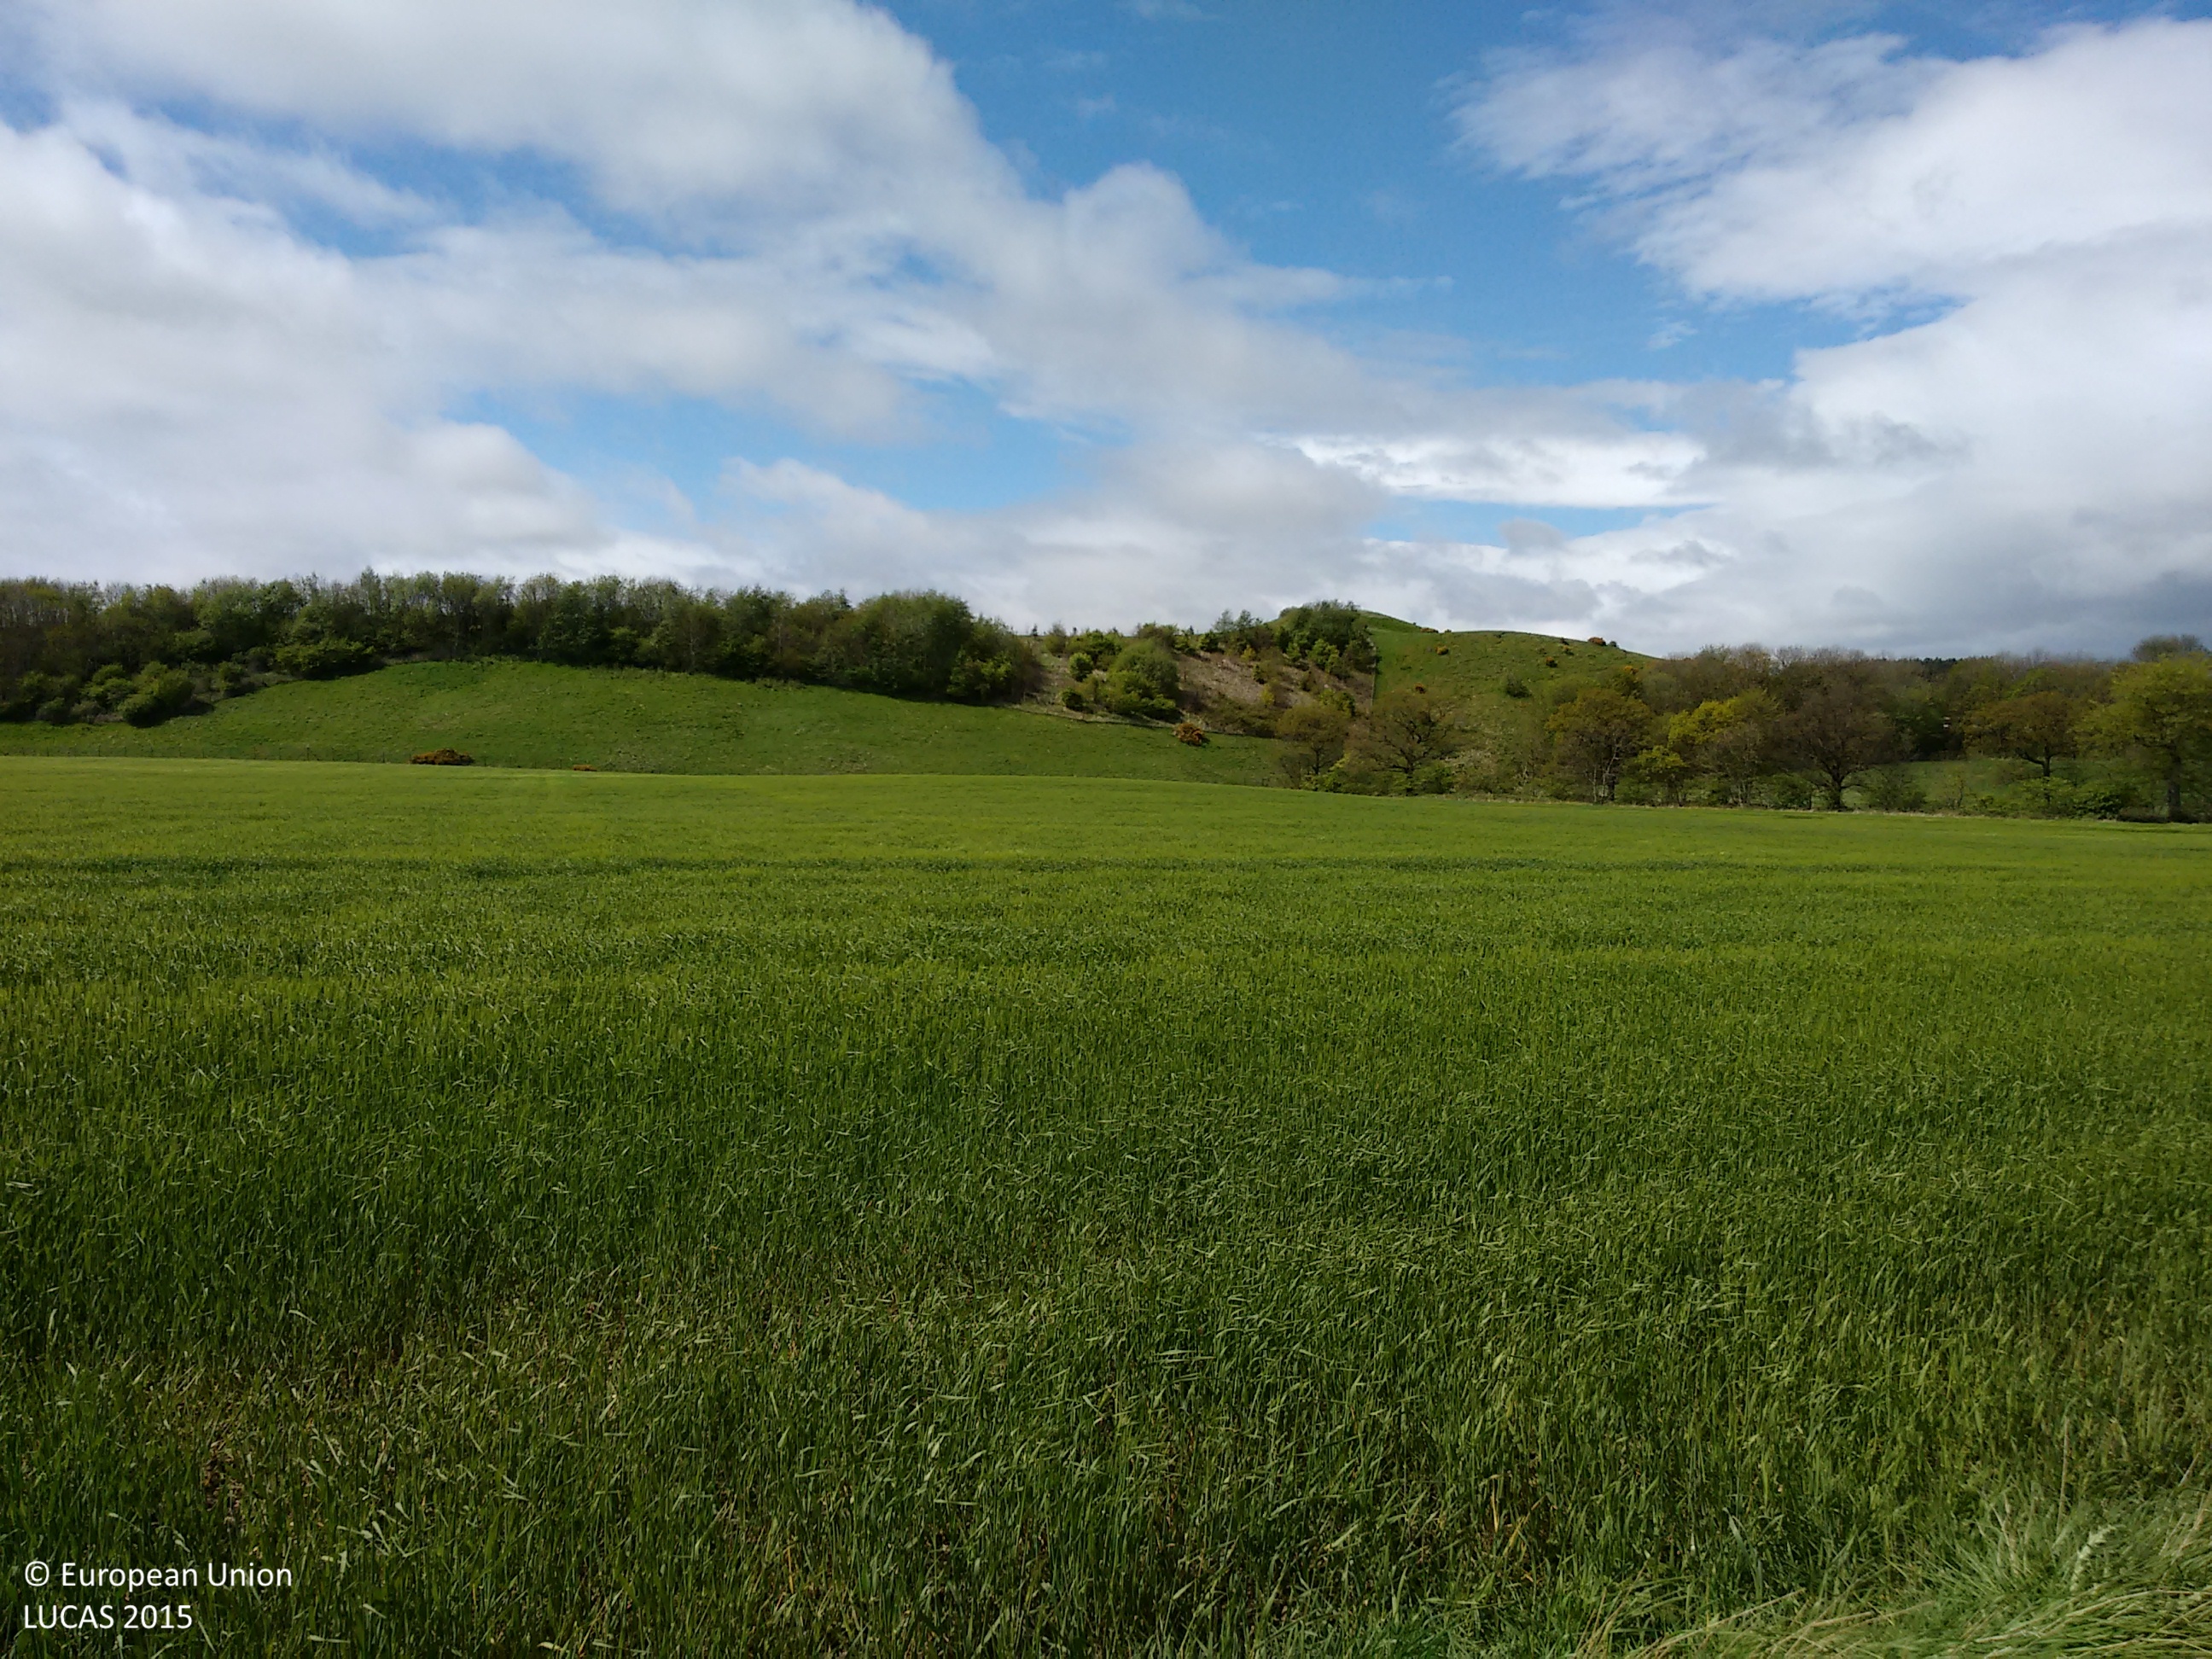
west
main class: Cropland
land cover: Barley
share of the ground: > 75 %
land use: Agriculture (excluding fallow land and kitchen gardens)
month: May
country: GB
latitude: 55.9778
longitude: -3.3597
